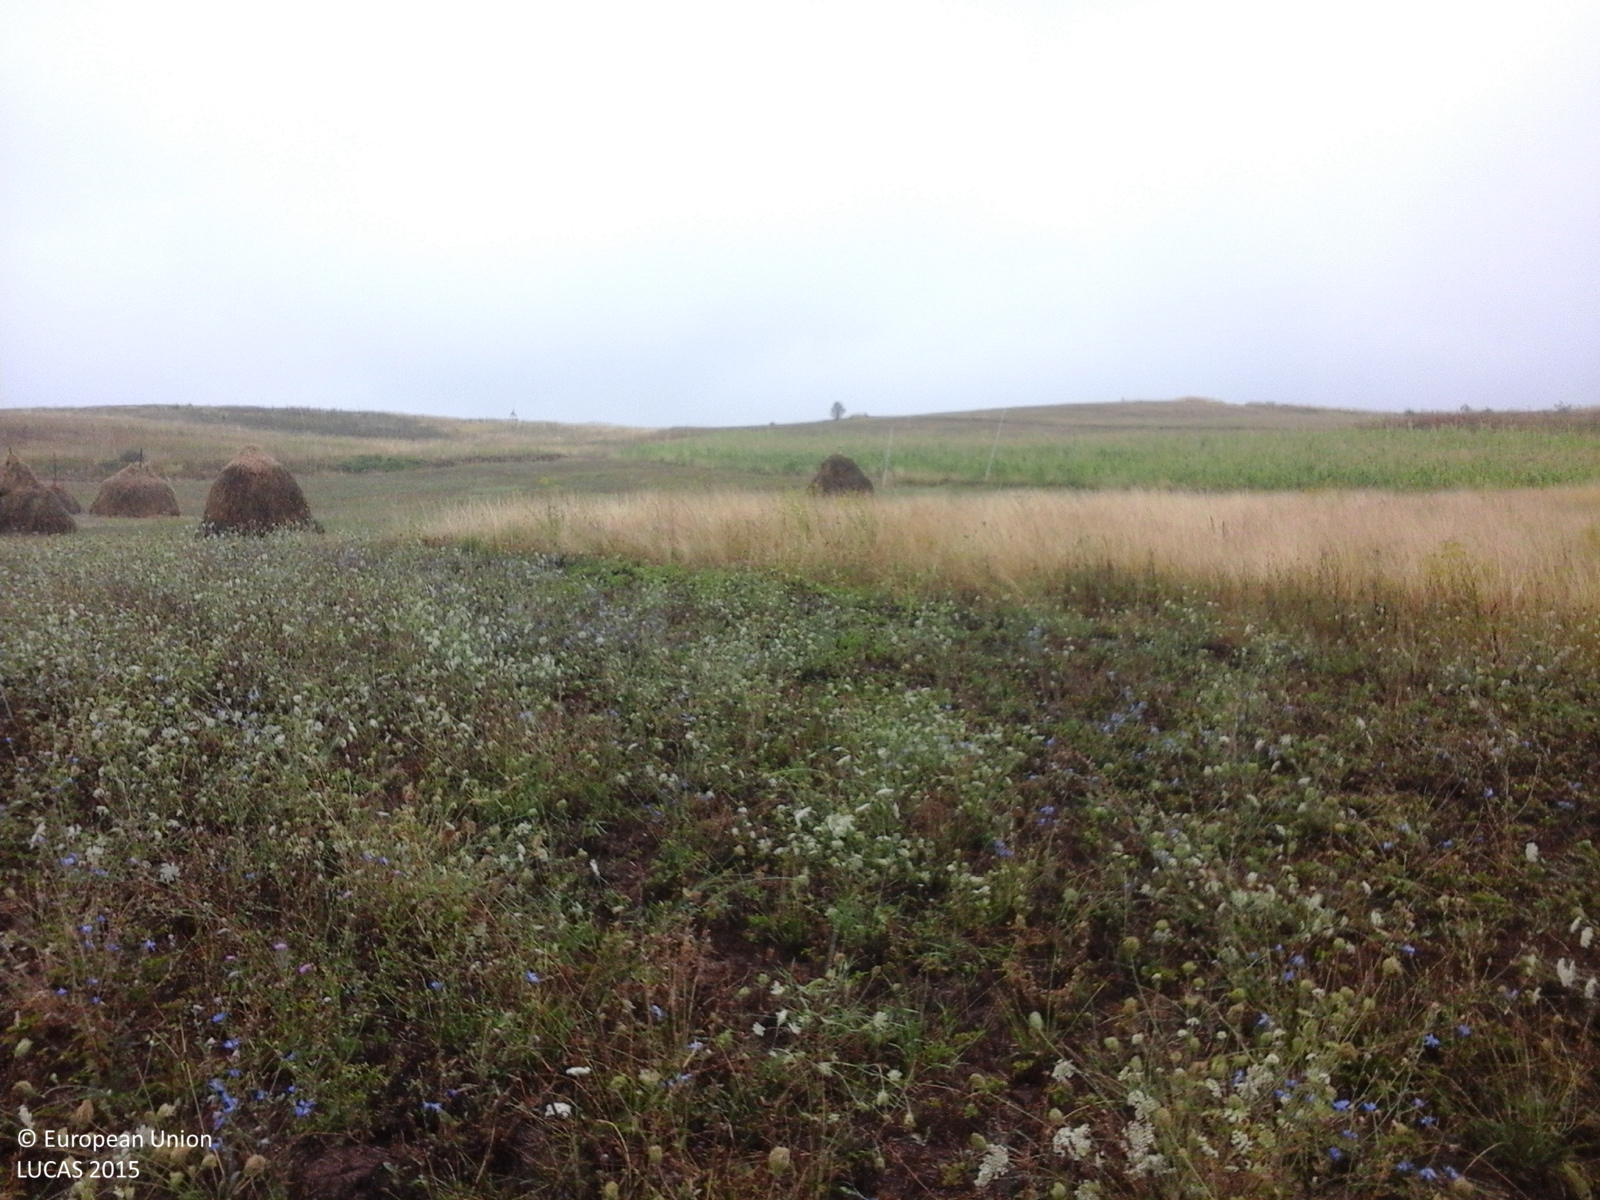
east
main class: Grassland
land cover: Spontaneously vegetated surfaces
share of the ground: > 75 %
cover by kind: herbaceous plants 100 %
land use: Fallow land
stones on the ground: 25 - 50 %
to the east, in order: Spontaneously vegetated surfaces; Grassland without tree/shrub cover; Maize; Grassland without tree/shrub cover; Tracks; Common wheat
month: August
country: RO
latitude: 44.8814
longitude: 22.0749
